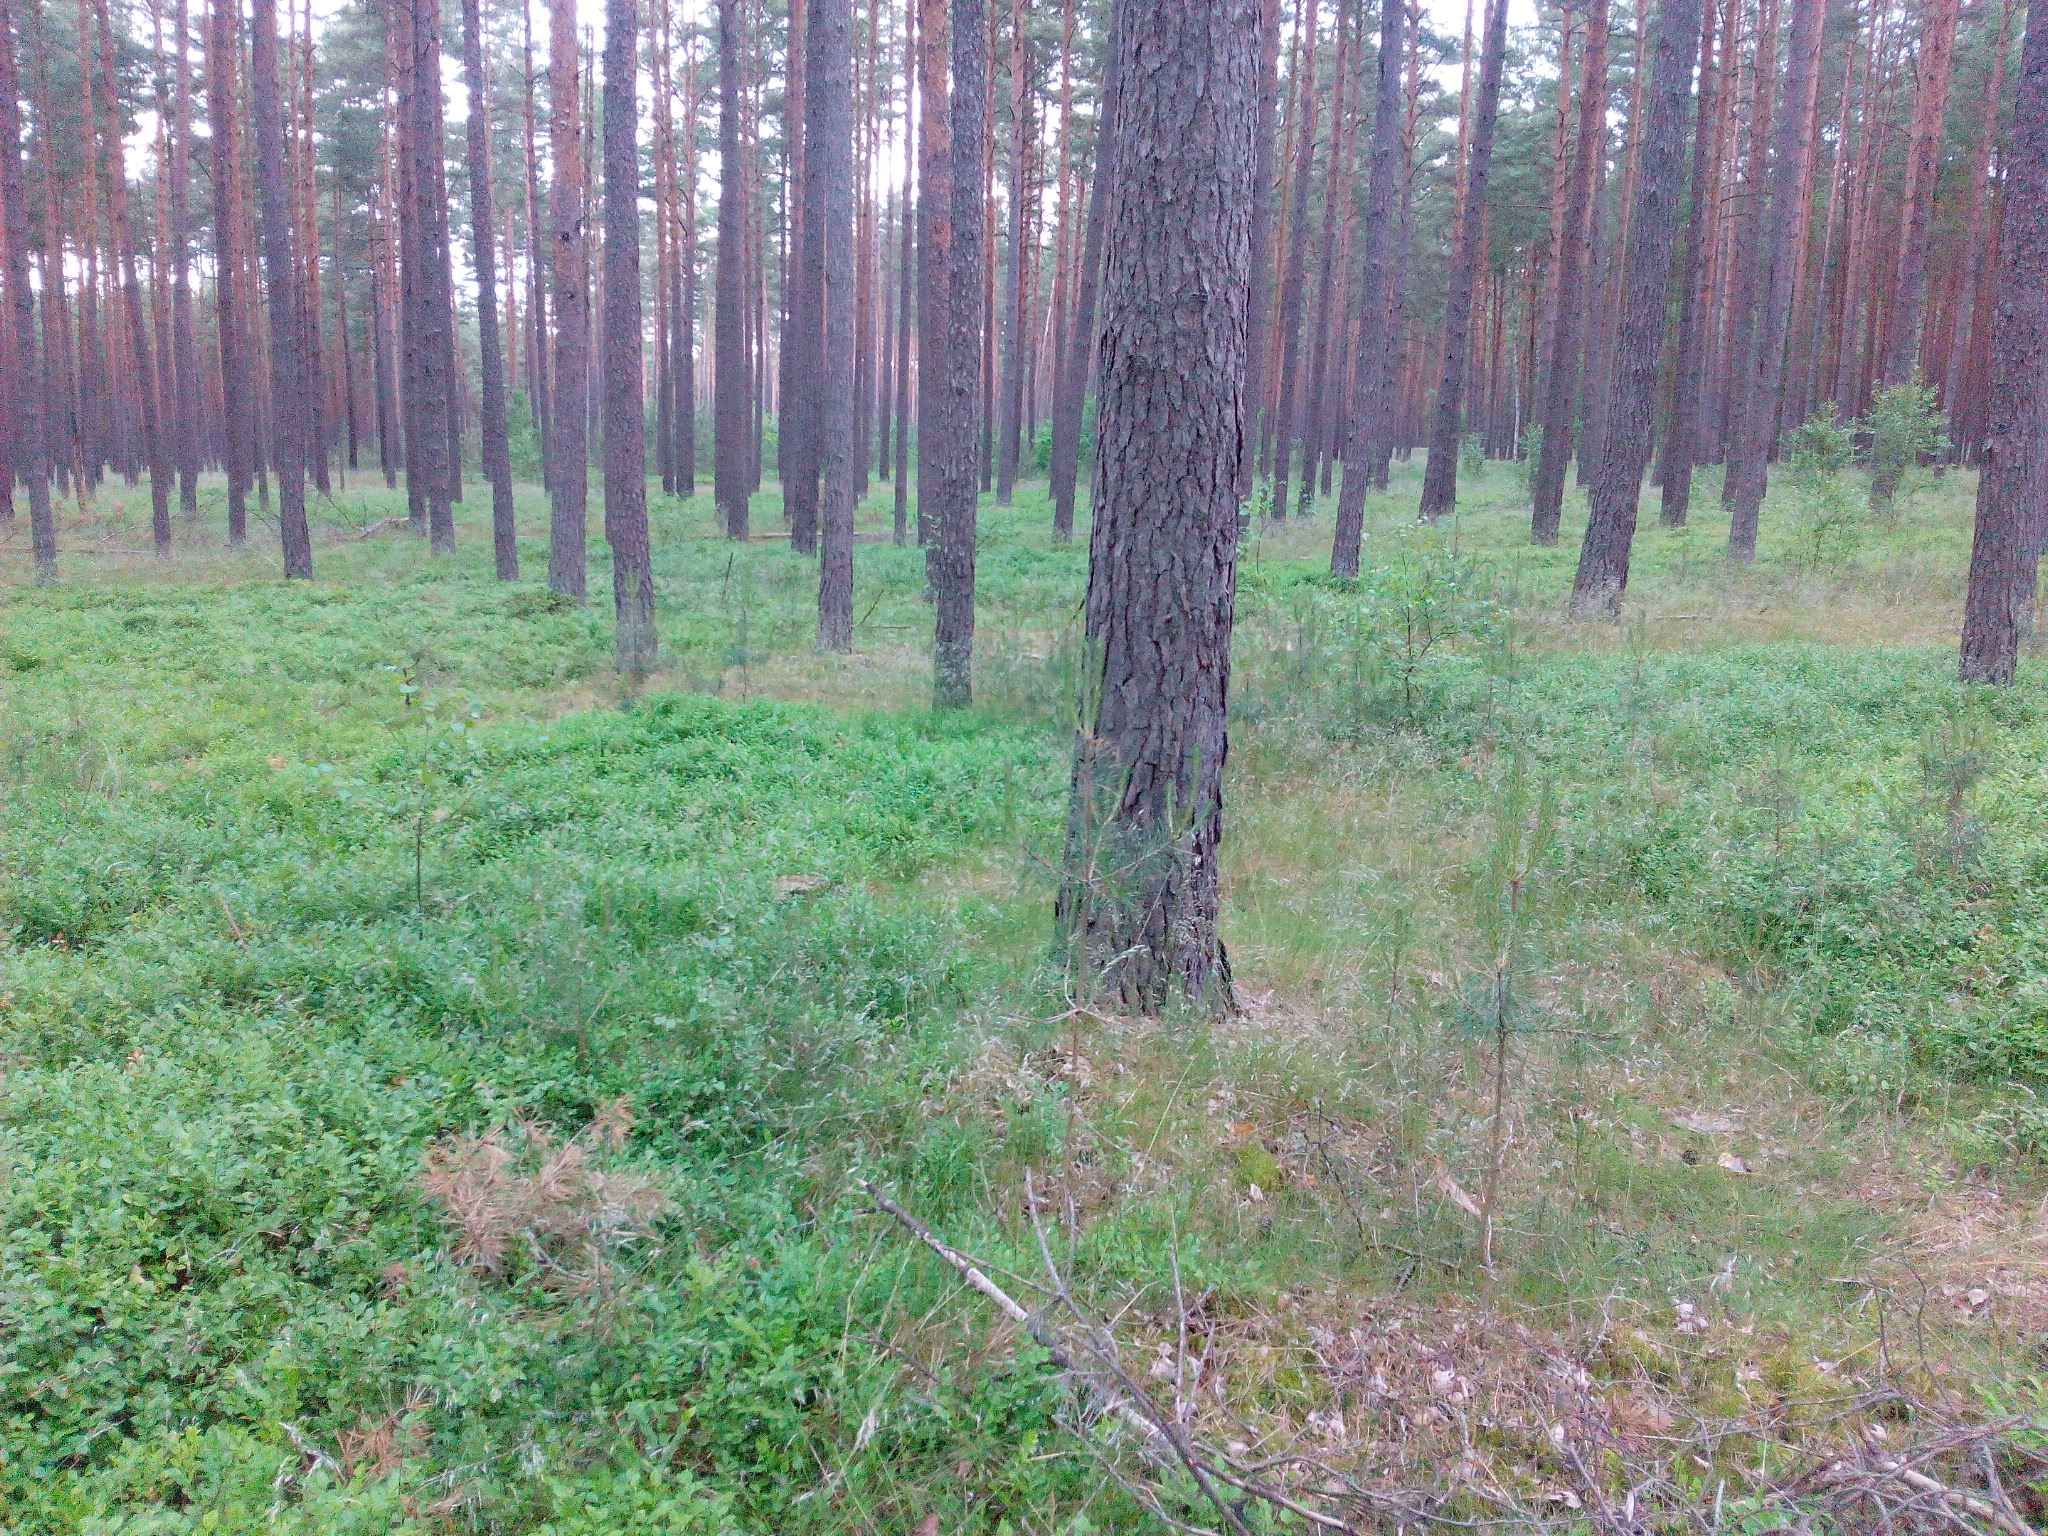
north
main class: Woodland
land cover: Pine dominated coniferous woodland
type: hemiboreal forest and nemoral coniferous forest and mixed broadleaved-coniferous forest
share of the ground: 50 - 75 %
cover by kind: coniferous forest trees 55 %, herbaceous plants 40 %, lichens and mosses 5 %
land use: Forestry
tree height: > 5 m
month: June
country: DE
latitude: 53.1981
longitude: 13.1882
